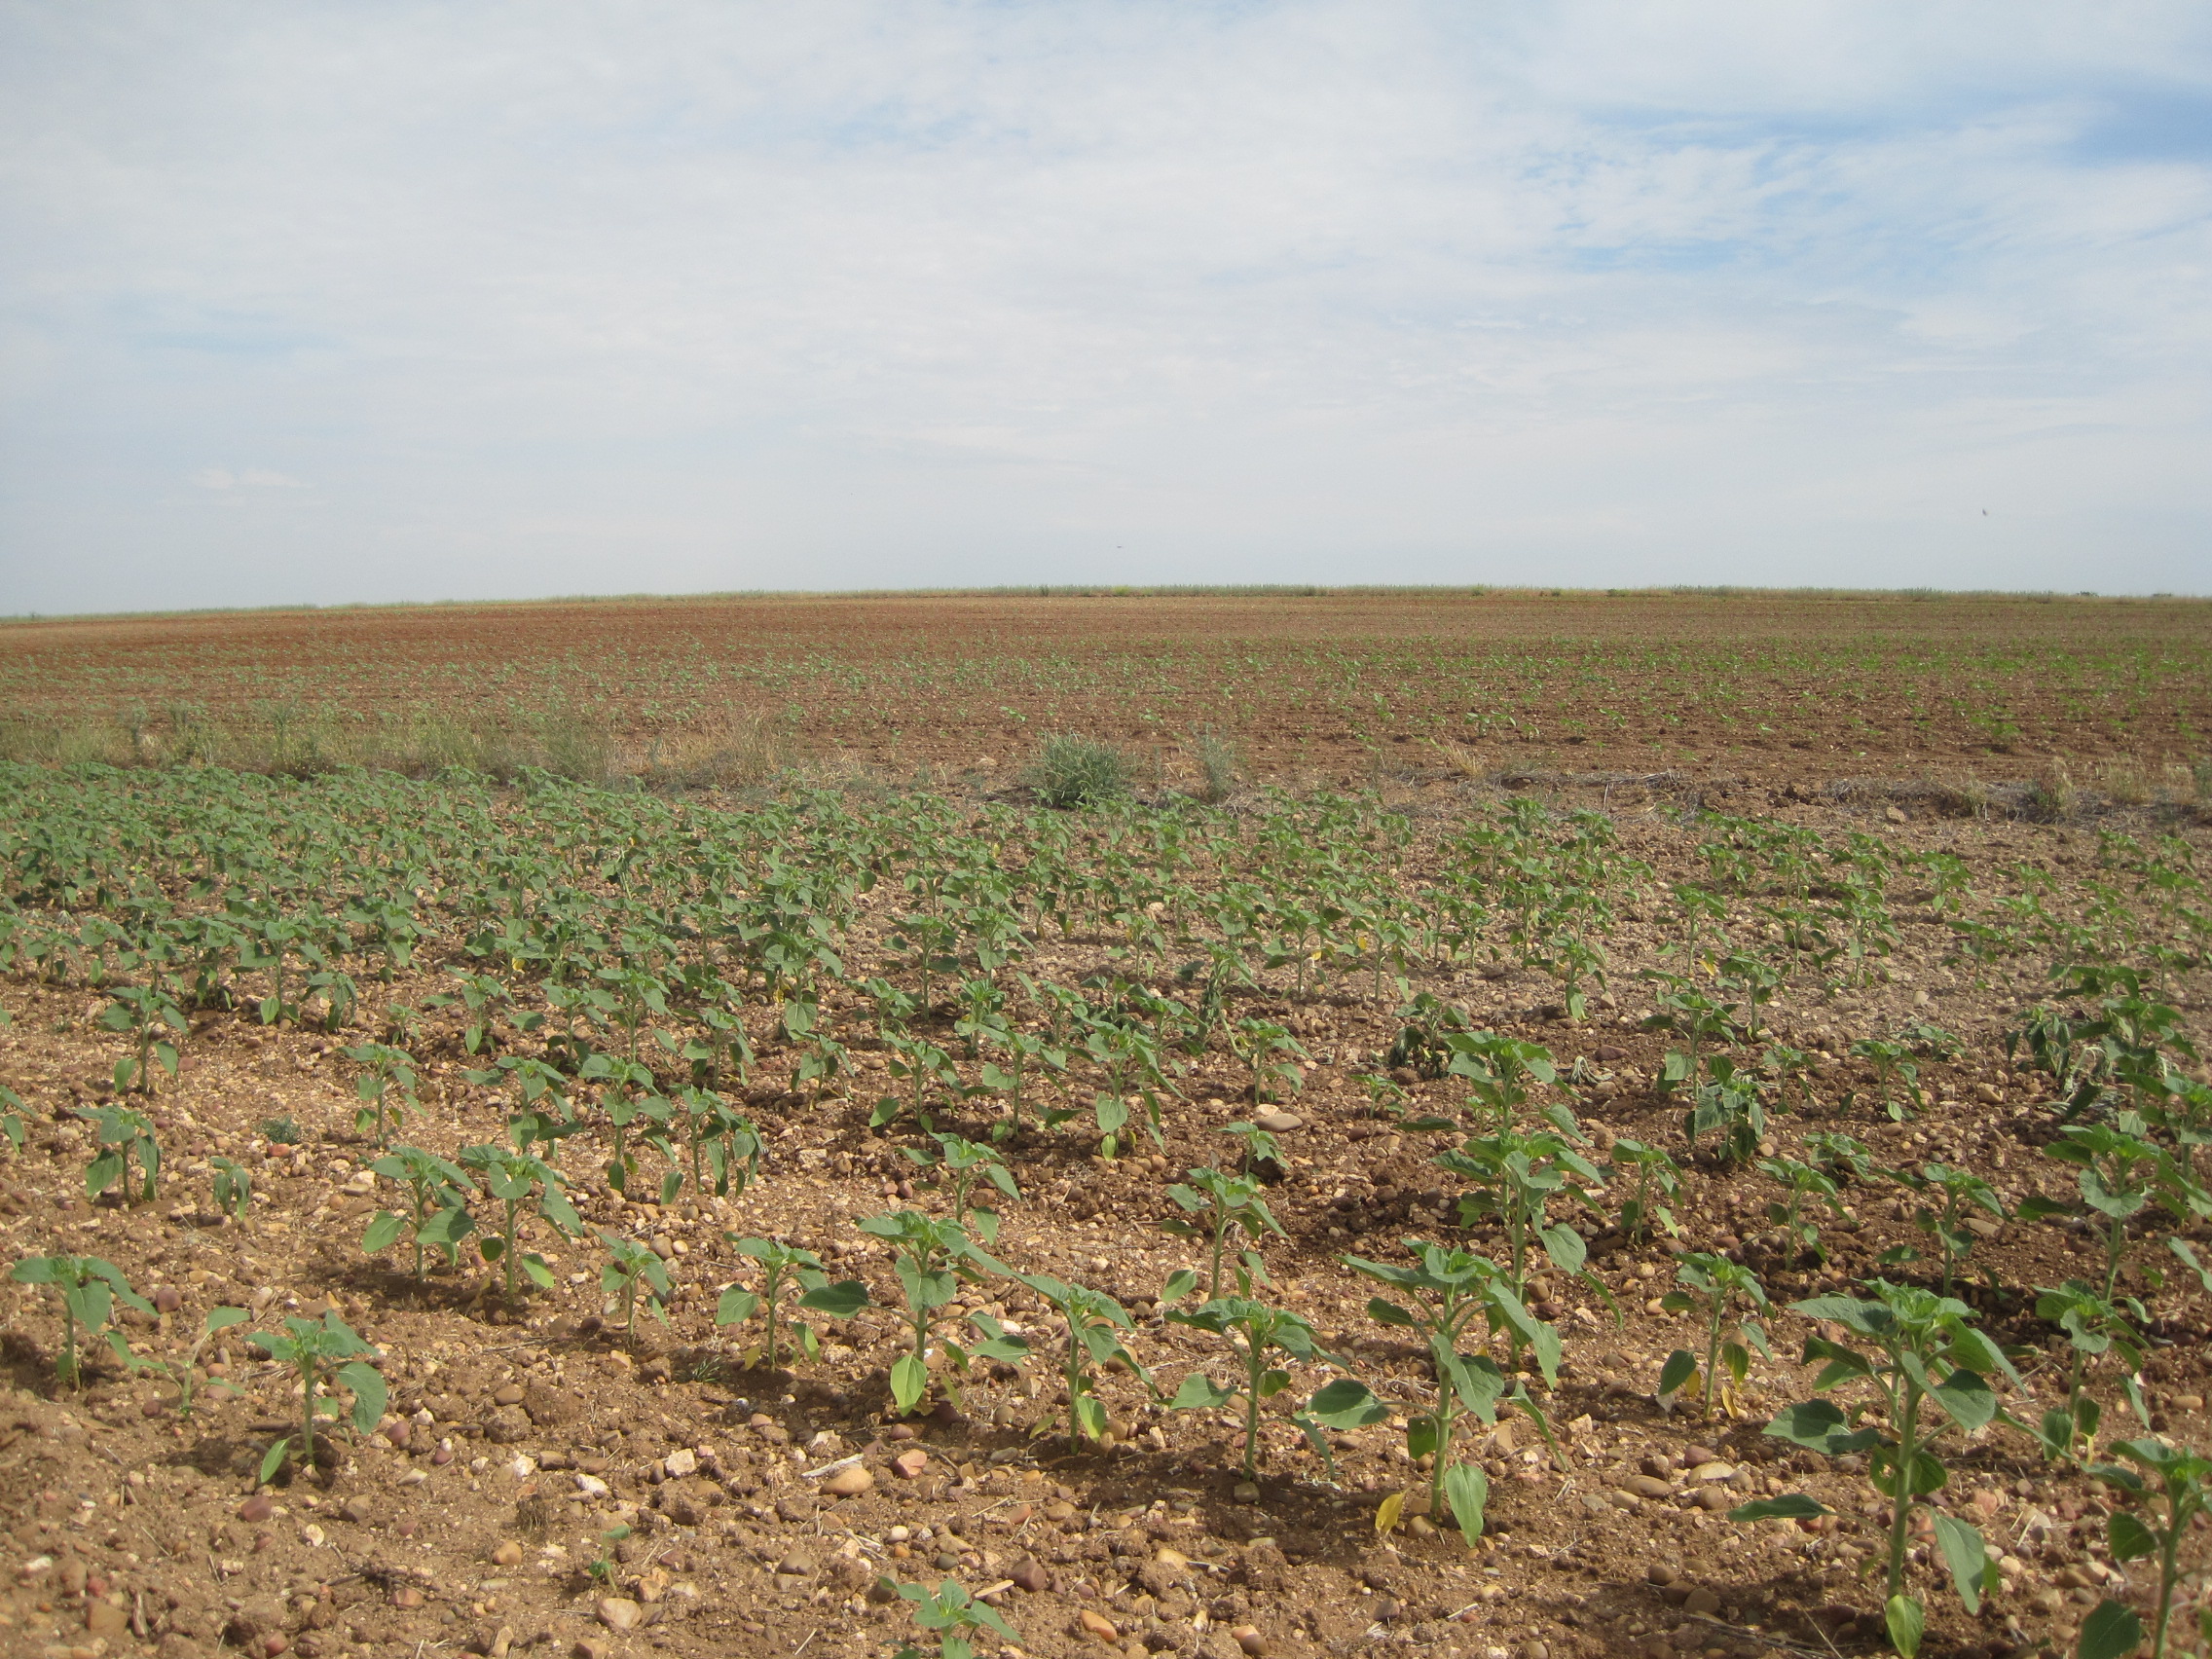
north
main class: Cropland
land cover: Sunflower
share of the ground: 50 - 75 %
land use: Agriculture (excluding fallow land and kitchen gardens)
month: June
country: ES
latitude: 41.3641
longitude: -5.1232
